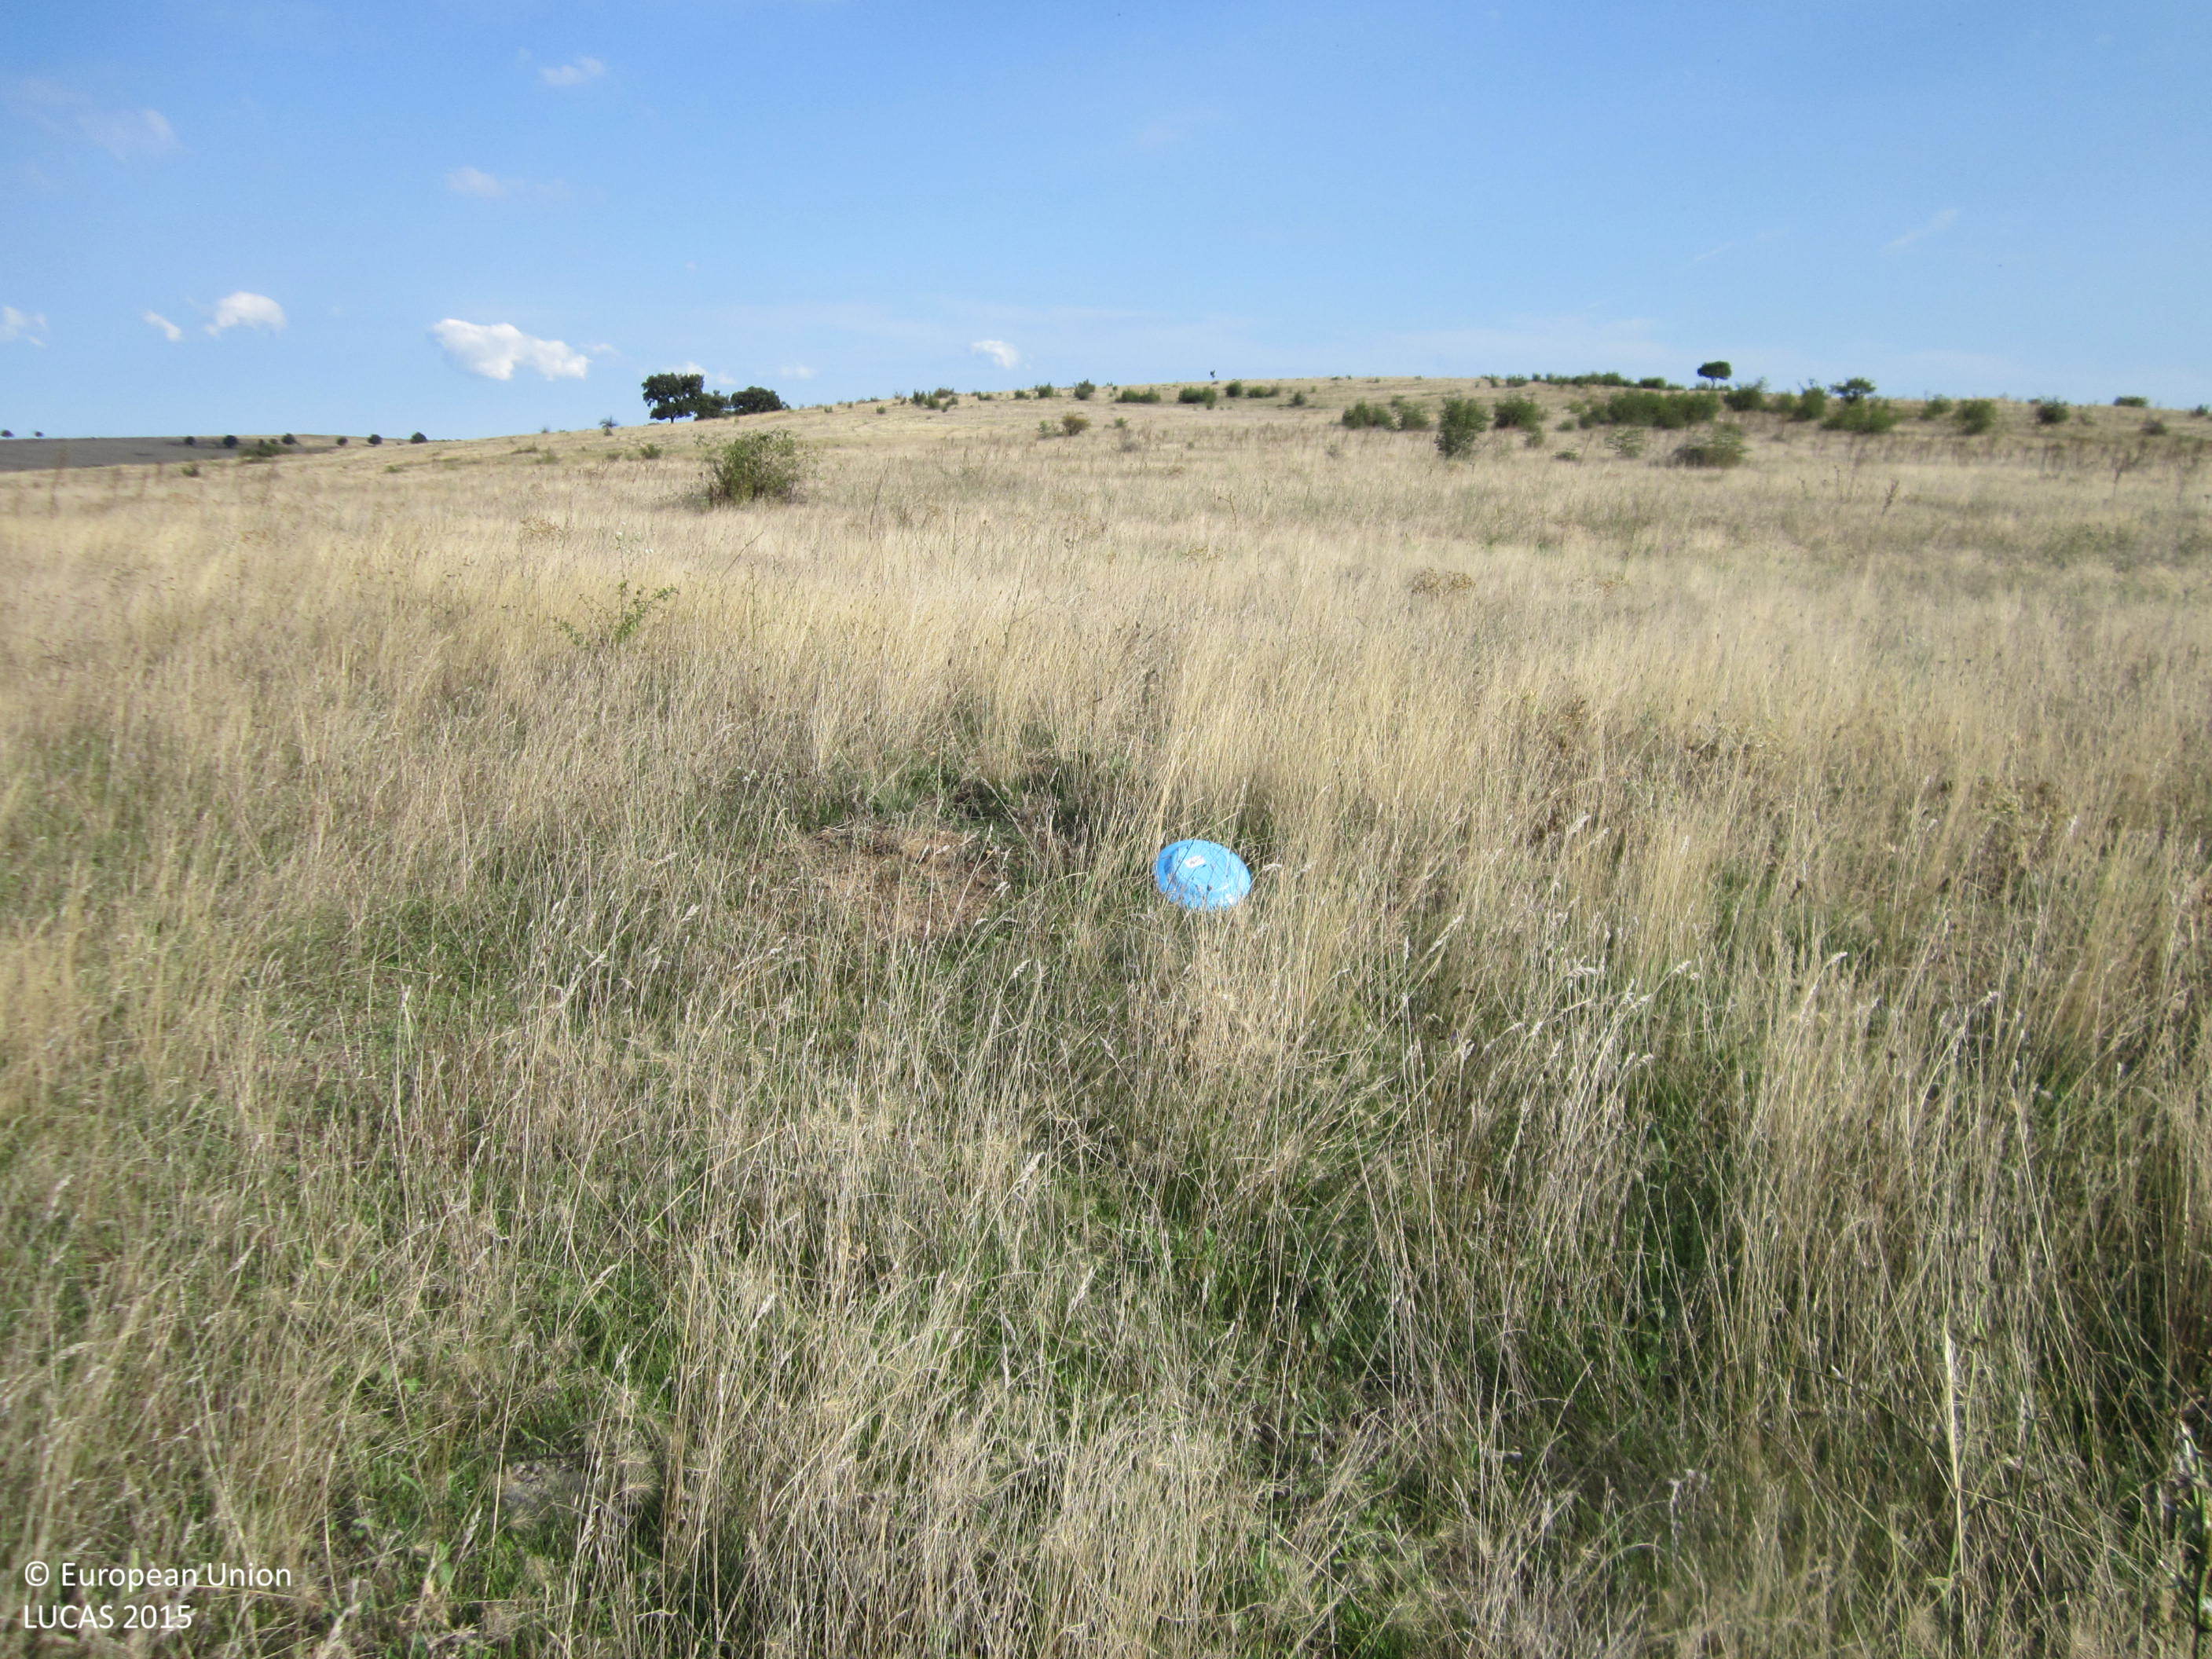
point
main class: Grassland
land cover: Grassland with sparse tree/shrub cover
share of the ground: > 75 %
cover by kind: herbaceous plants 90 %, broadleaved forest trees 5 %, shrubs 5 %
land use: Agriculture (excluding fallow land and kitchen gardens)
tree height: < 5 m
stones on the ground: < 10 %
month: September
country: BG
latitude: 42.6464
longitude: 27.0746
